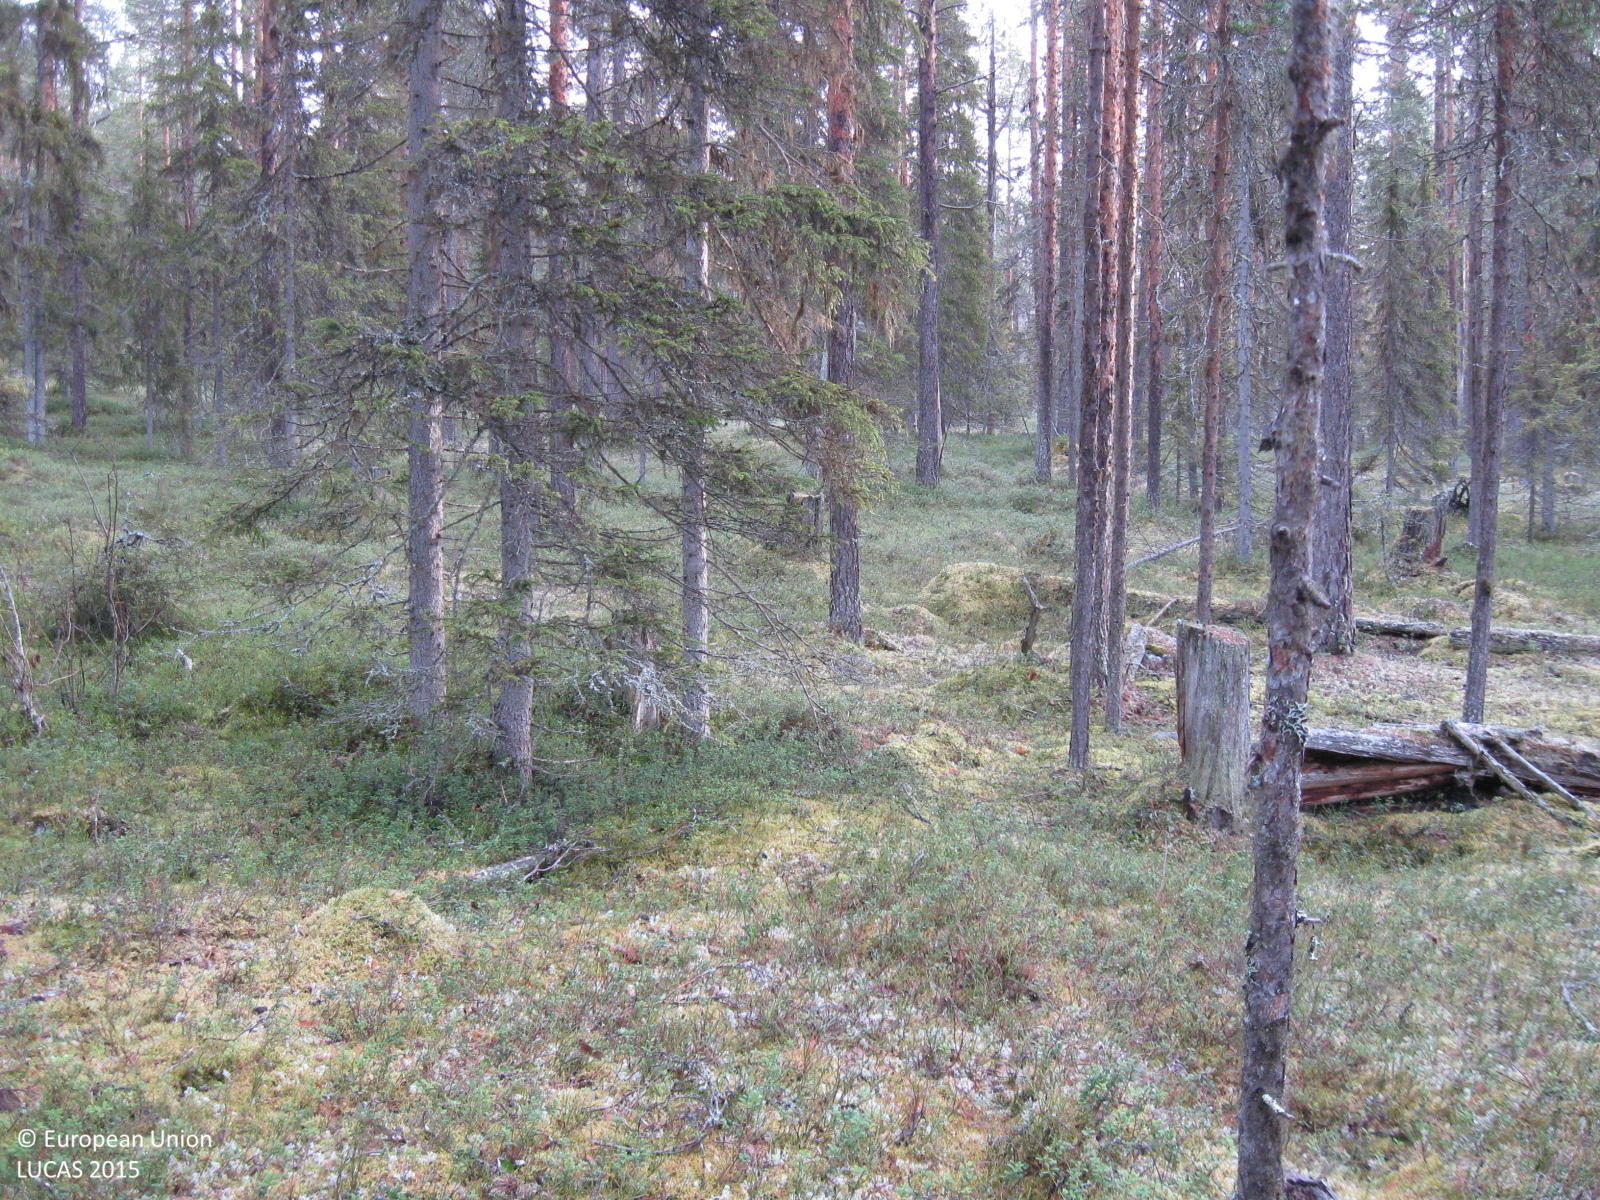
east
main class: Woodland
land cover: Pine dominated coniferous woodland
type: boreal forest
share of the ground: 50 - 75 %
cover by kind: coniferous forest trees 70 %, shrubs 15 %, lichens and mosses 10 %, herbaceous plants 5 %
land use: Forestry
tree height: > 5 m
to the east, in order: Pine dominated coniferous woodland; Other coniferous woodland; Spruce dominated coniferous woodland; Rivers and streams; Spruce dominated mixed woodland
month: October
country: SE
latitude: 66.4134
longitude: 20.9564
